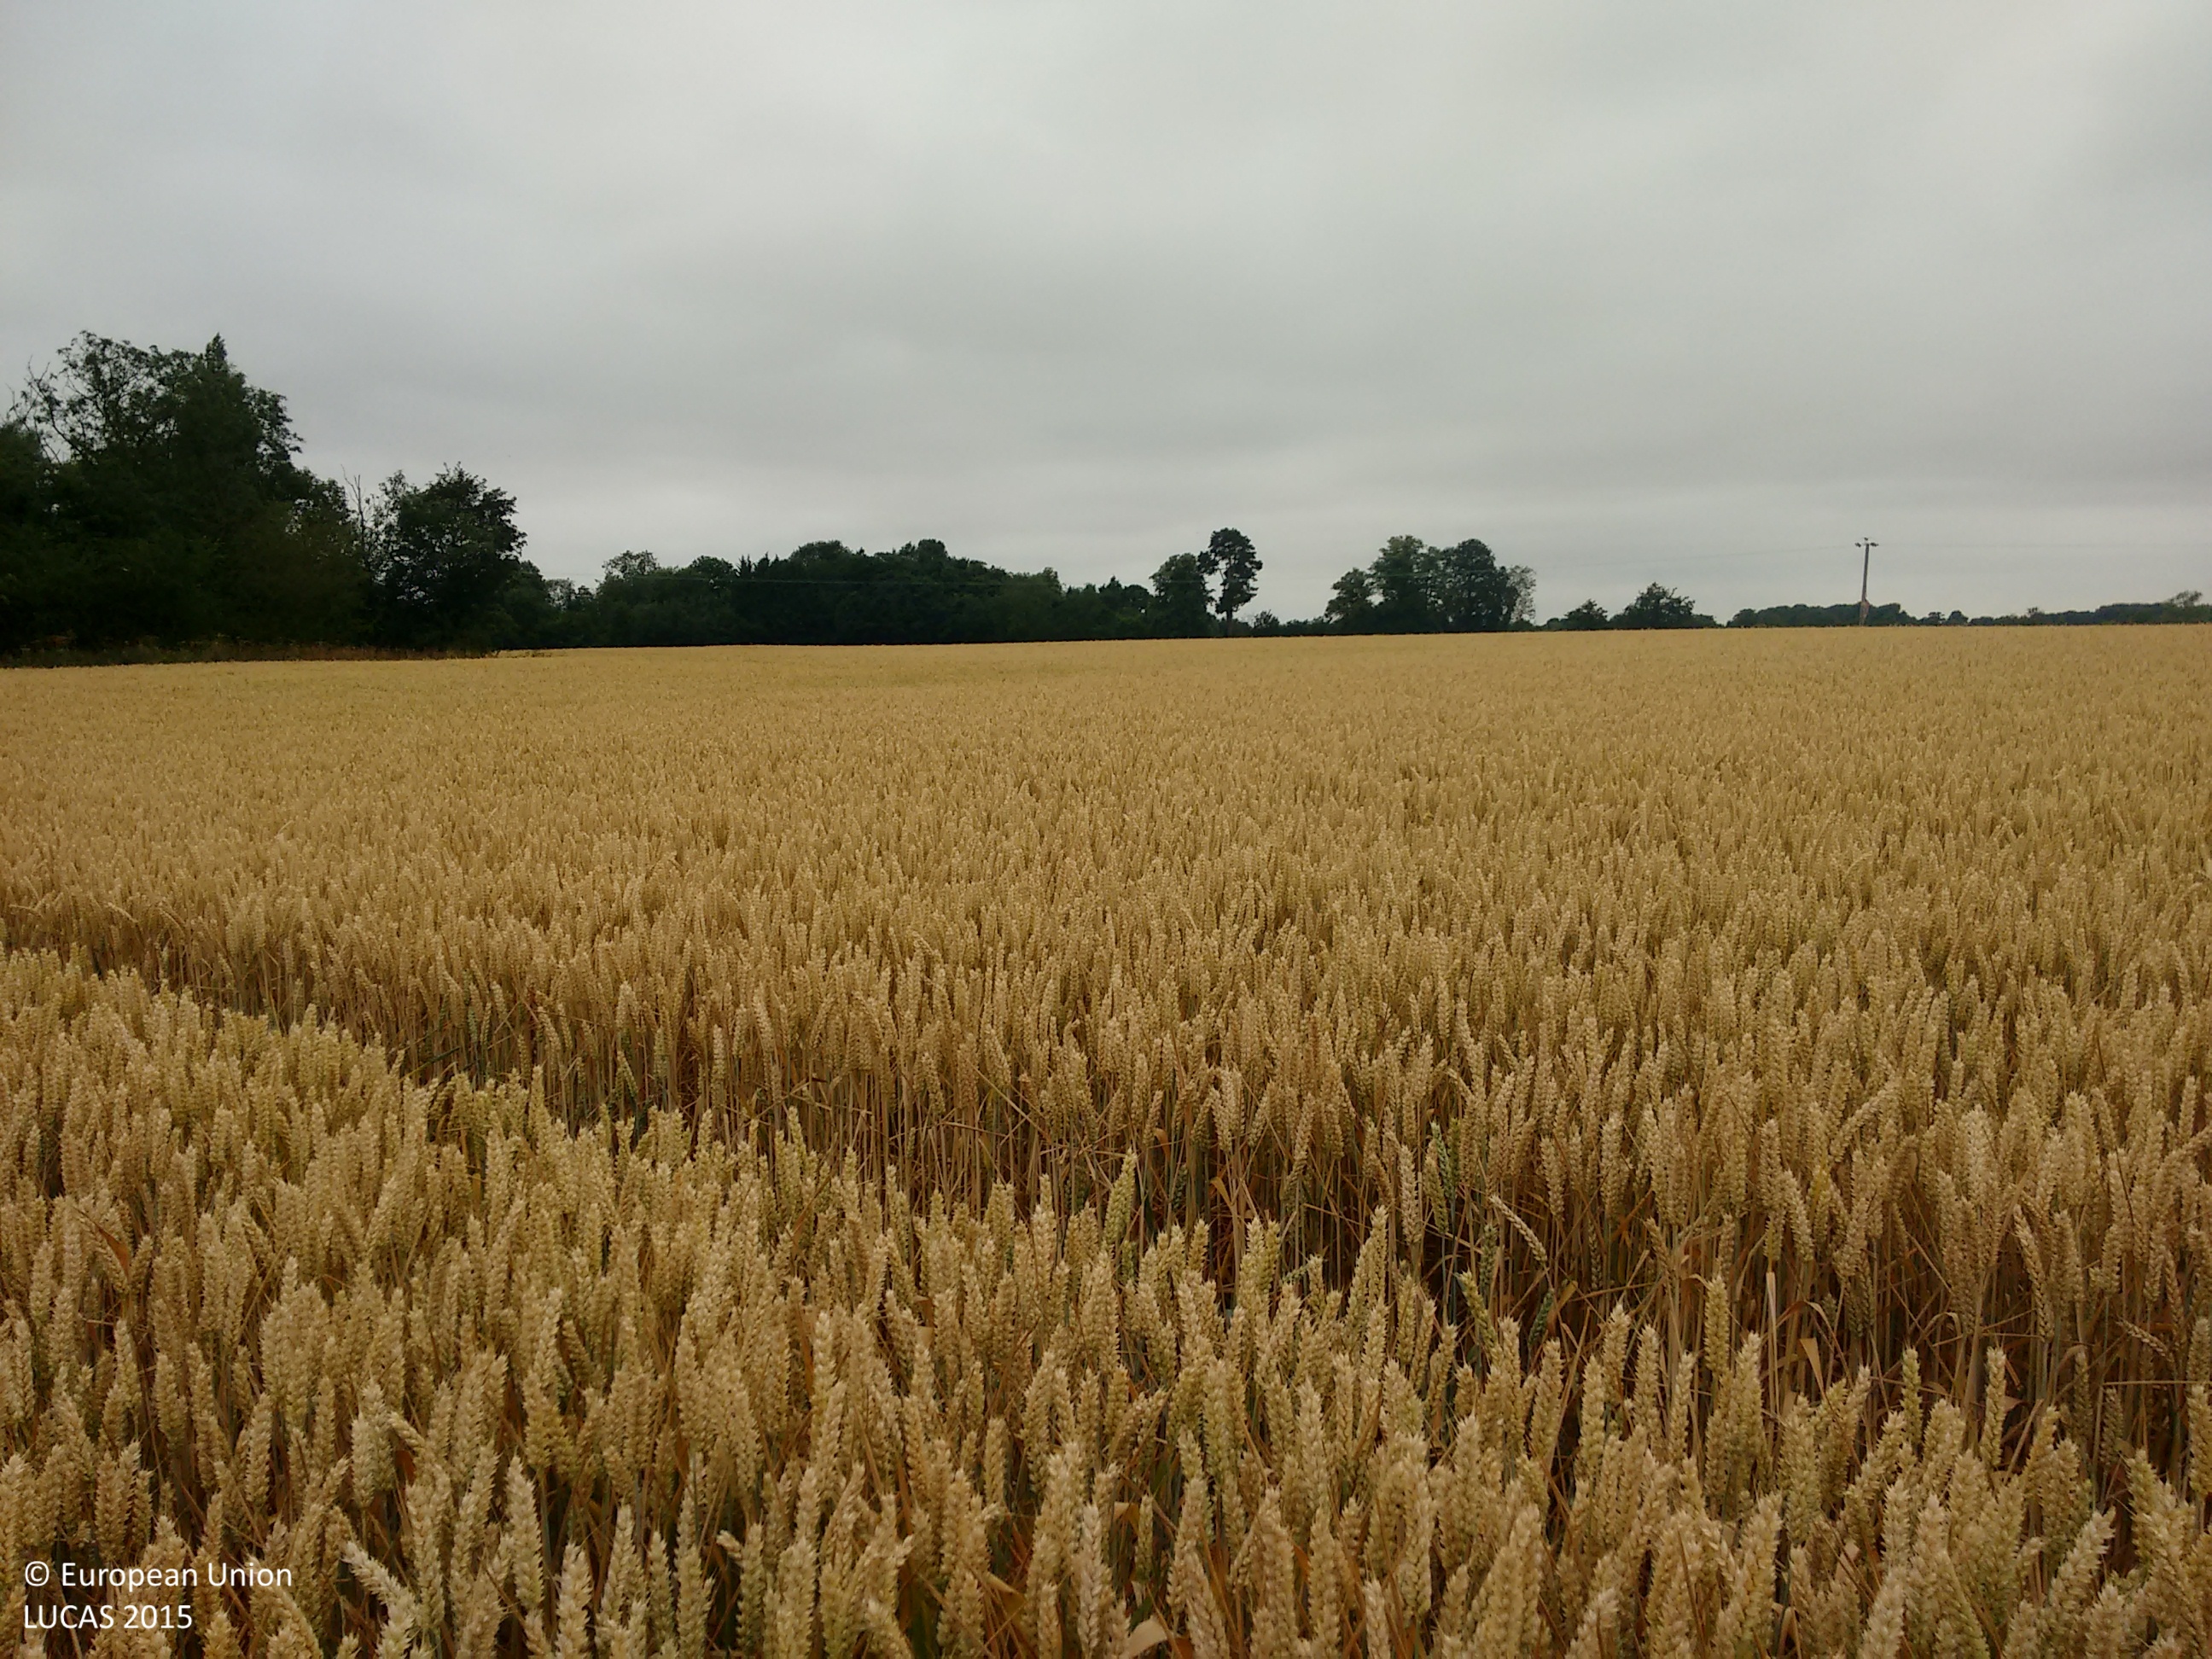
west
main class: Cropland
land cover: Common wheat
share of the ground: > 75 %
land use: Agriculture (excluding fallow land and kitchen gardens)
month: July
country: GB
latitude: 51.8183
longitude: 0.3233
